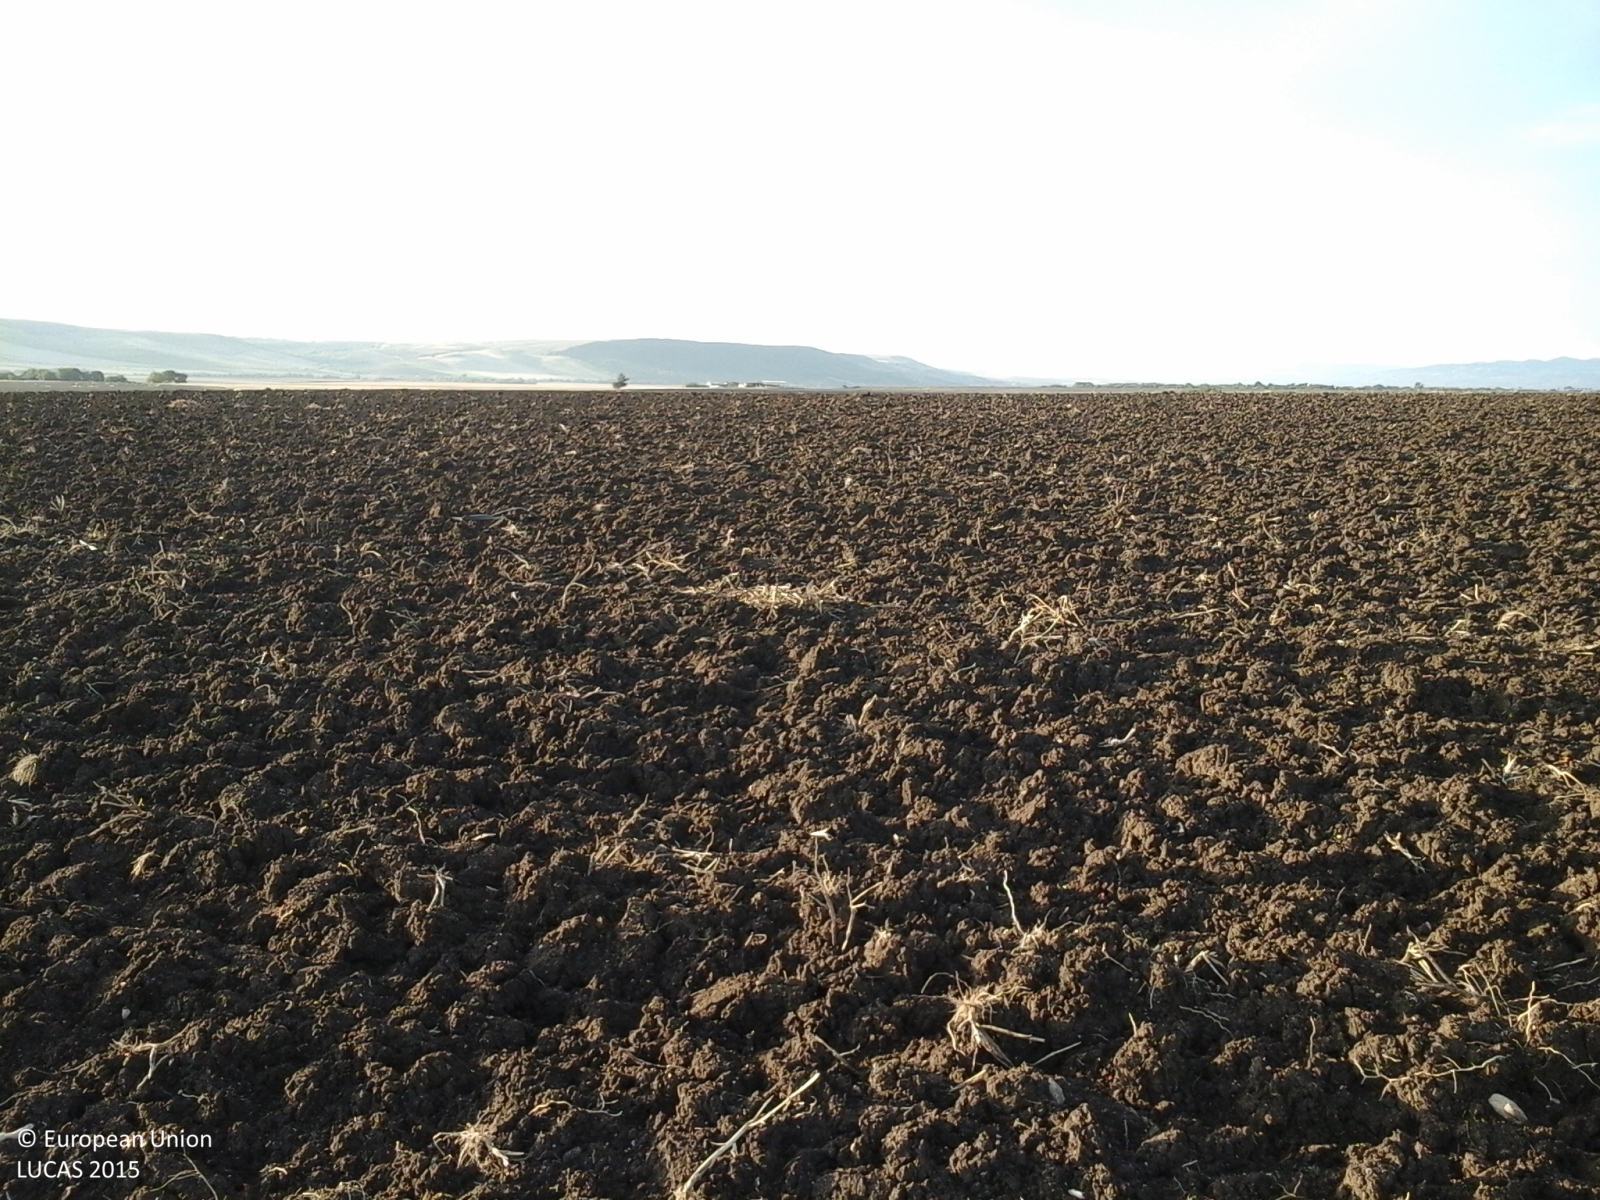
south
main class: Cropland
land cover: Tomatoes
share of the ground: > 75 %
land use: Agriculture (excluding fallow land and kitchen gardens)
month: October
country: IT
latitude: 41.8496
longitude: 15.2233
